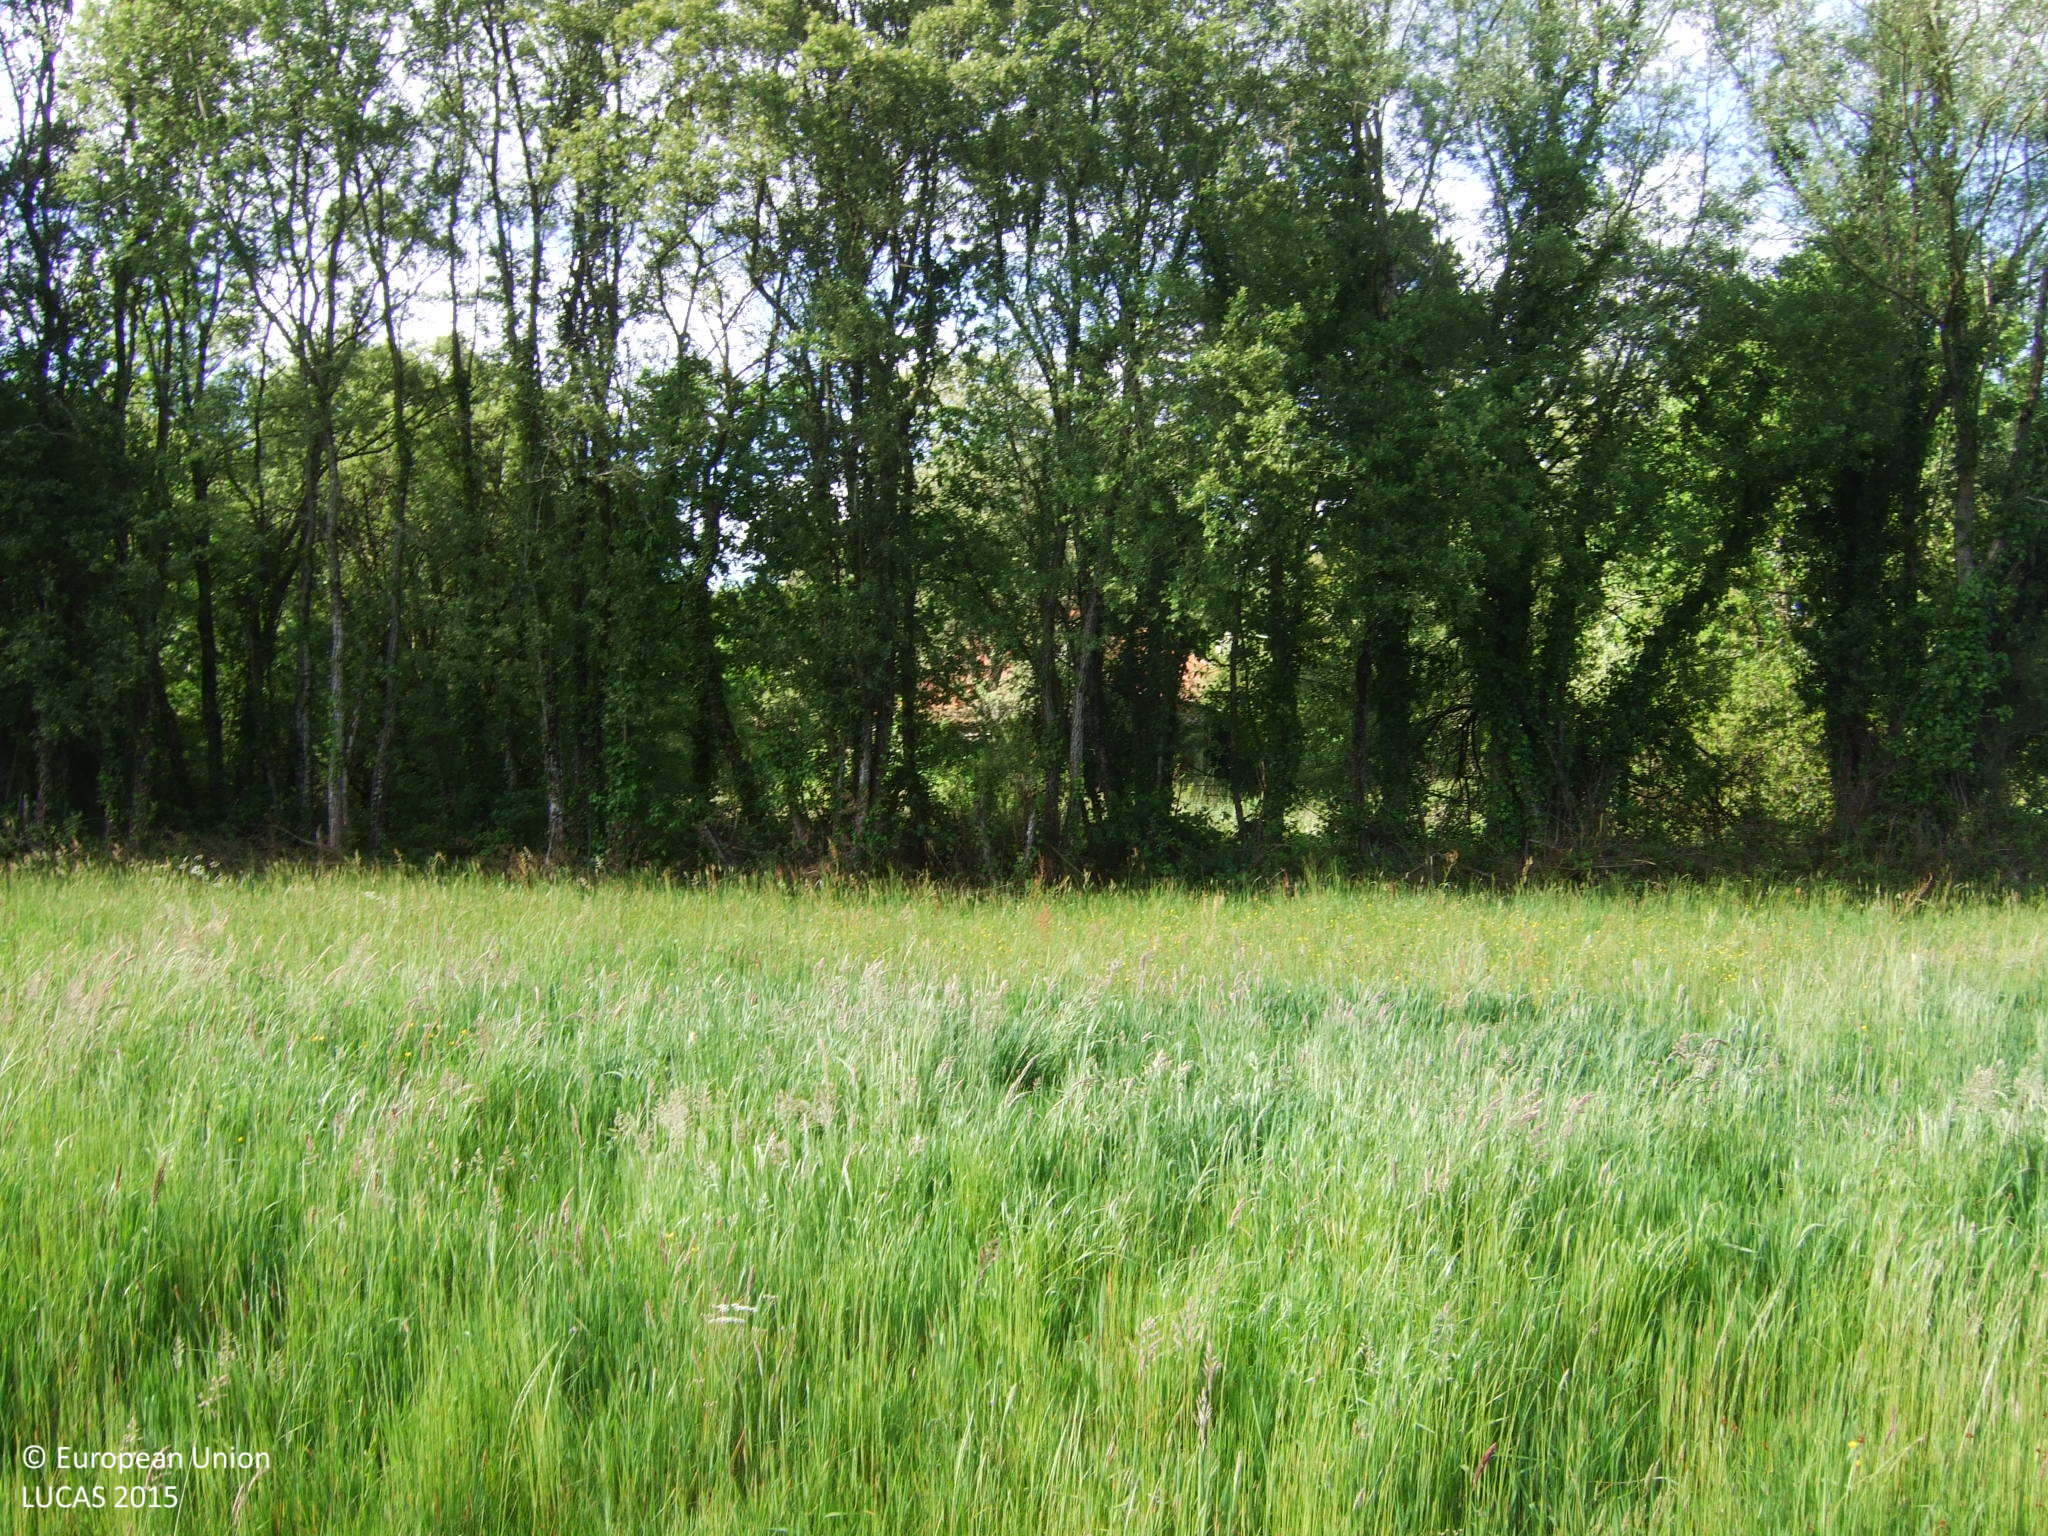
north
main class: Grassland
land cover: Grassland without tree/shrub cover
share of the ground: > 75 %
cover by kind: herbaceous plants 100 %
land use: Agriculture (excluding fallow land and kitchen gardens)
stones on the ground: < 10 %
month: May
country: ES
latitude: 43.1873
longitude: -7.4626
